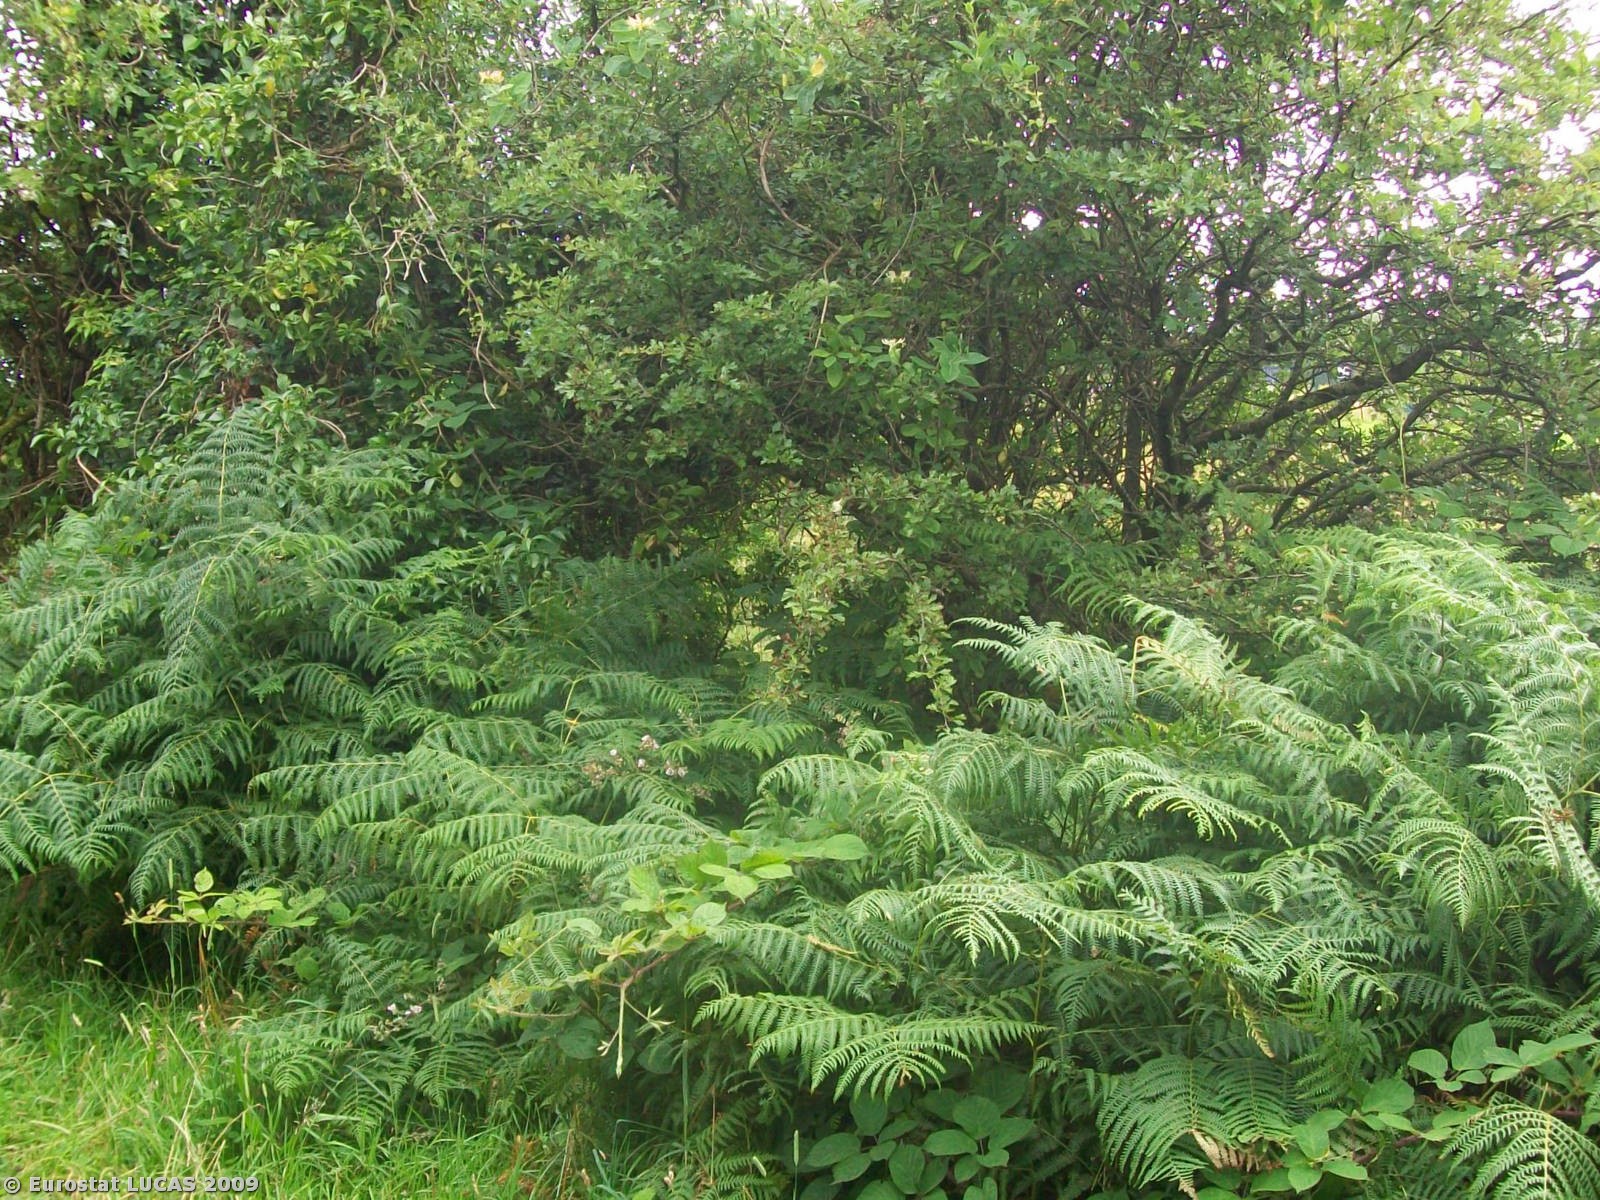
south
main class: Woodland
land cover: Coniferous woodland
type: plantations and self-sown exotic forest
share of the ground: > 75 %
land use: Forestry
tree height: > 5 m
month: July
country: IE
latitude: 54.0489
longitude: -9.0774
